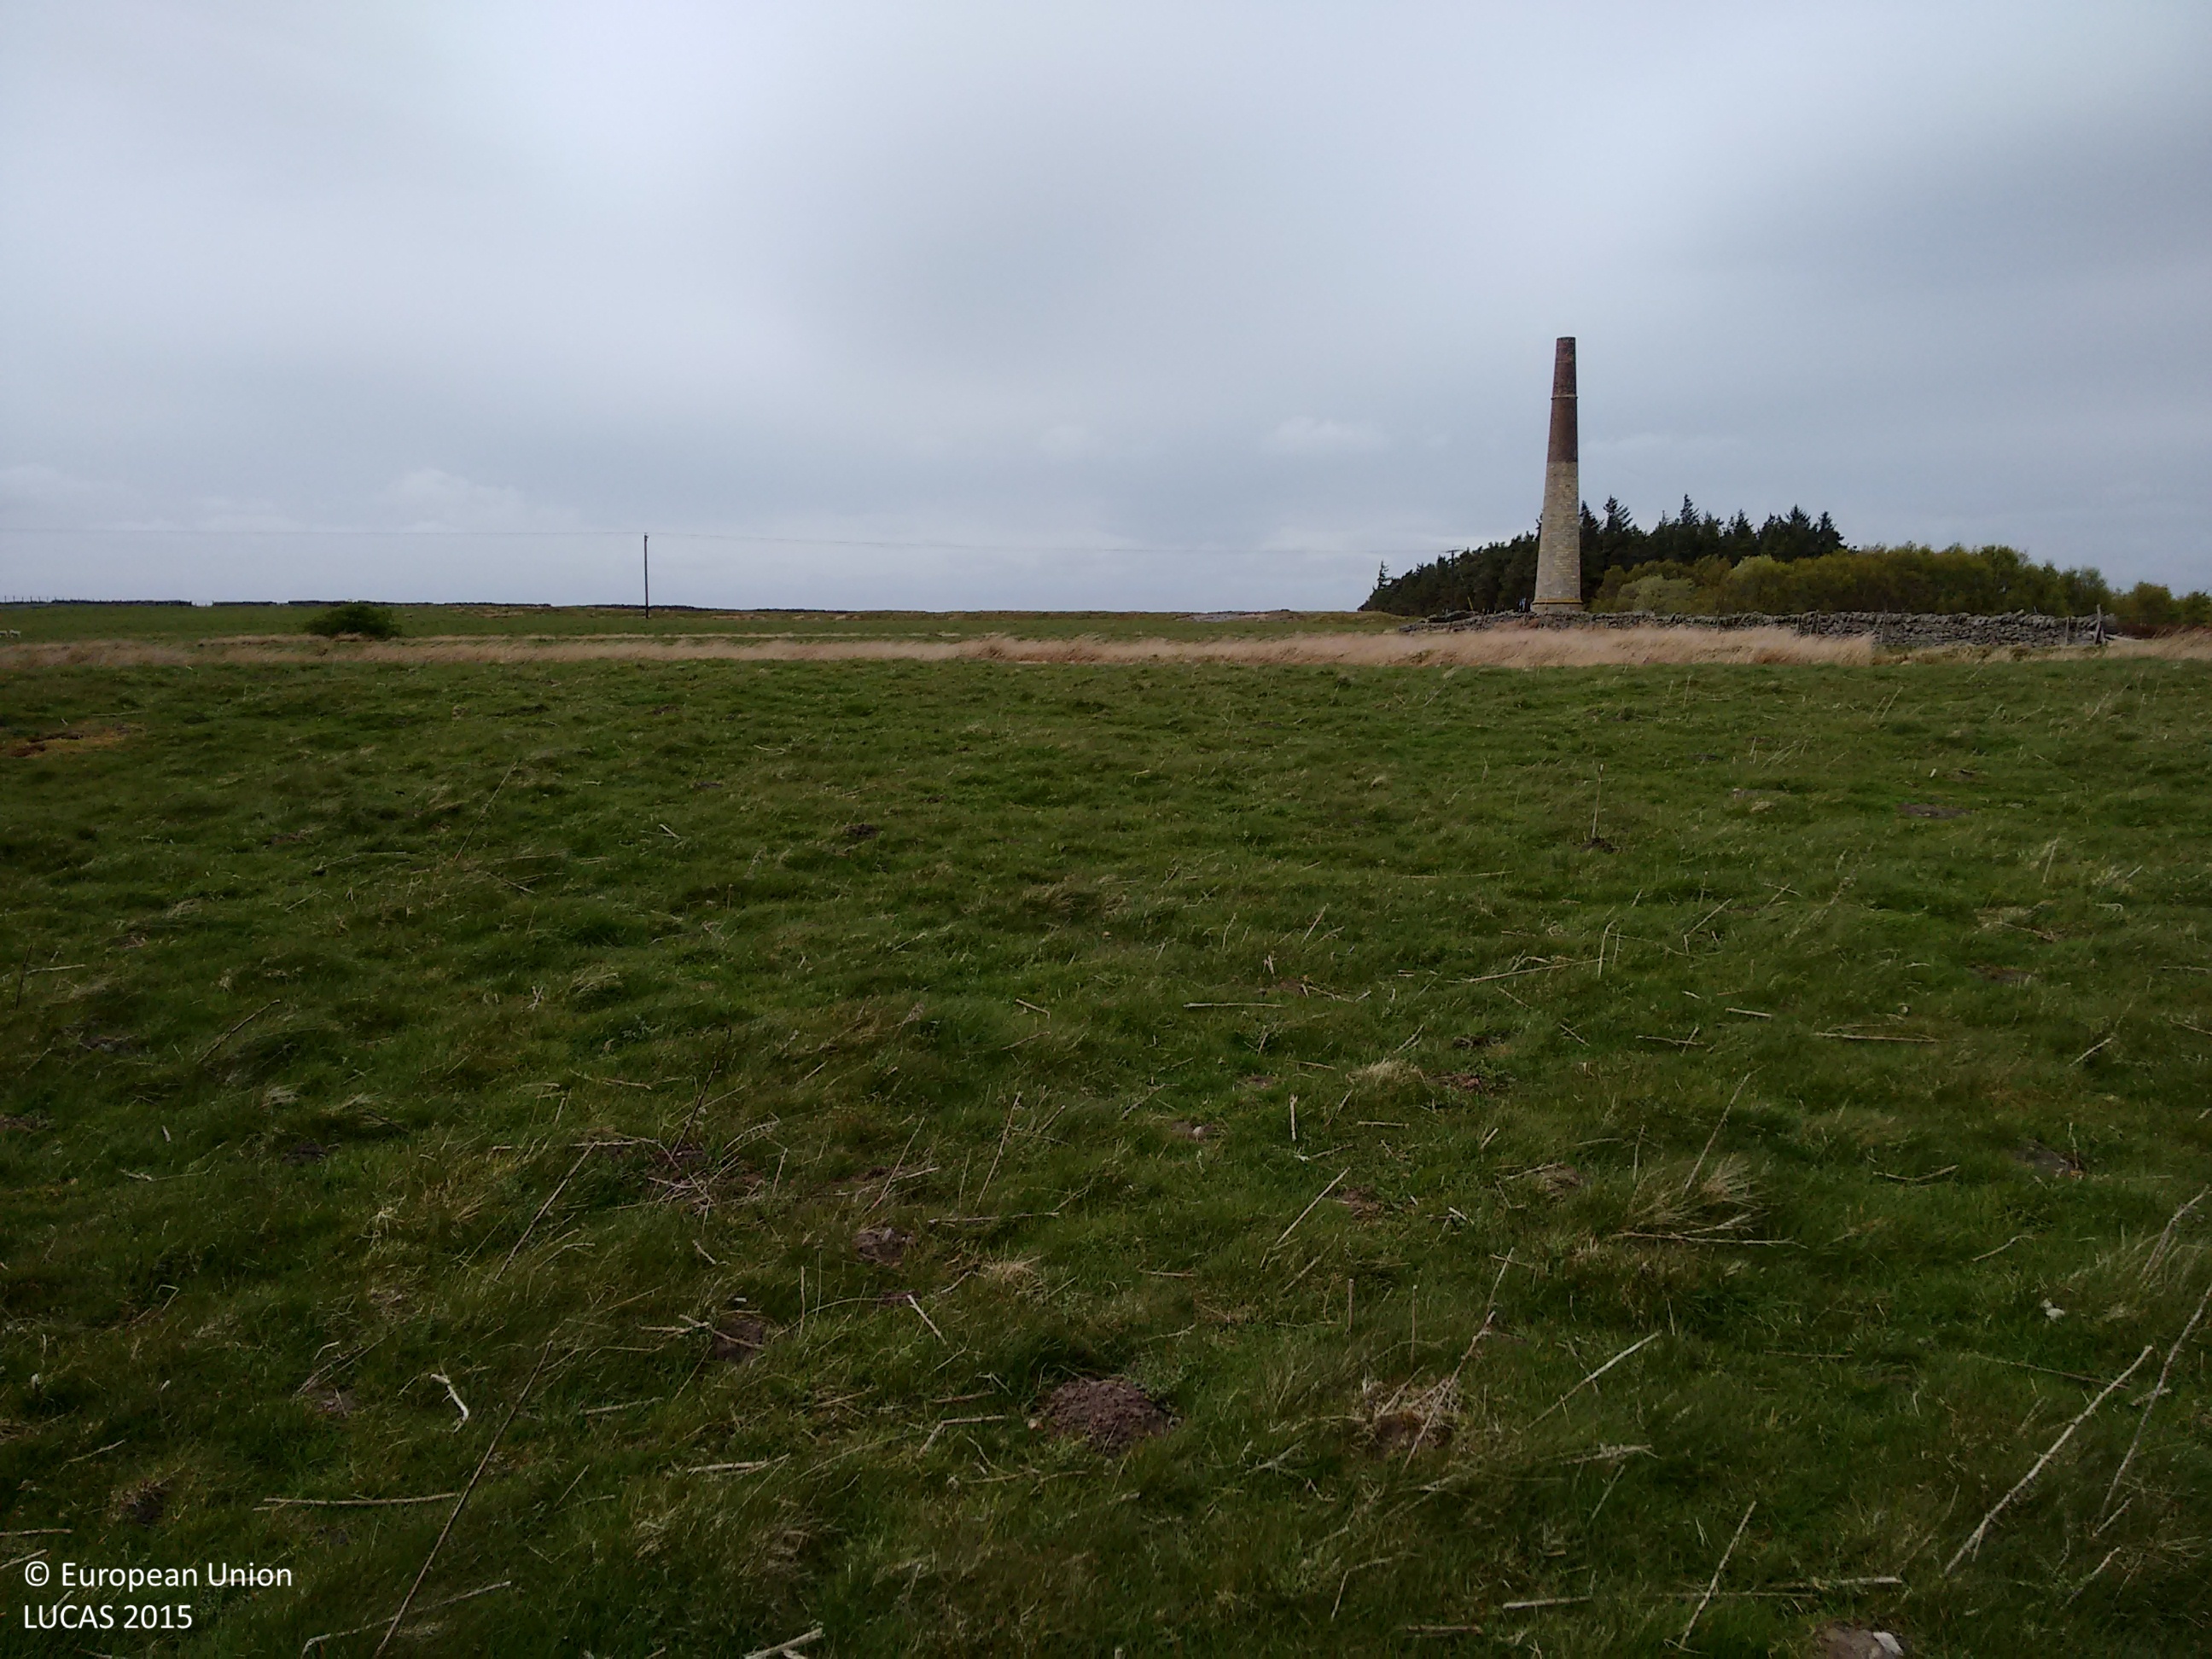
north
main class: Grassland
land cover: Grassland without tree/shrub cover
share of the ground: > 75 %
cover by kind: herbaceous plants 100 %
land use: Agriculture (excluding fallow land and kitchen gardens)
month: May
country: GB
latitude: 54.9427
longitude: -2.2506
